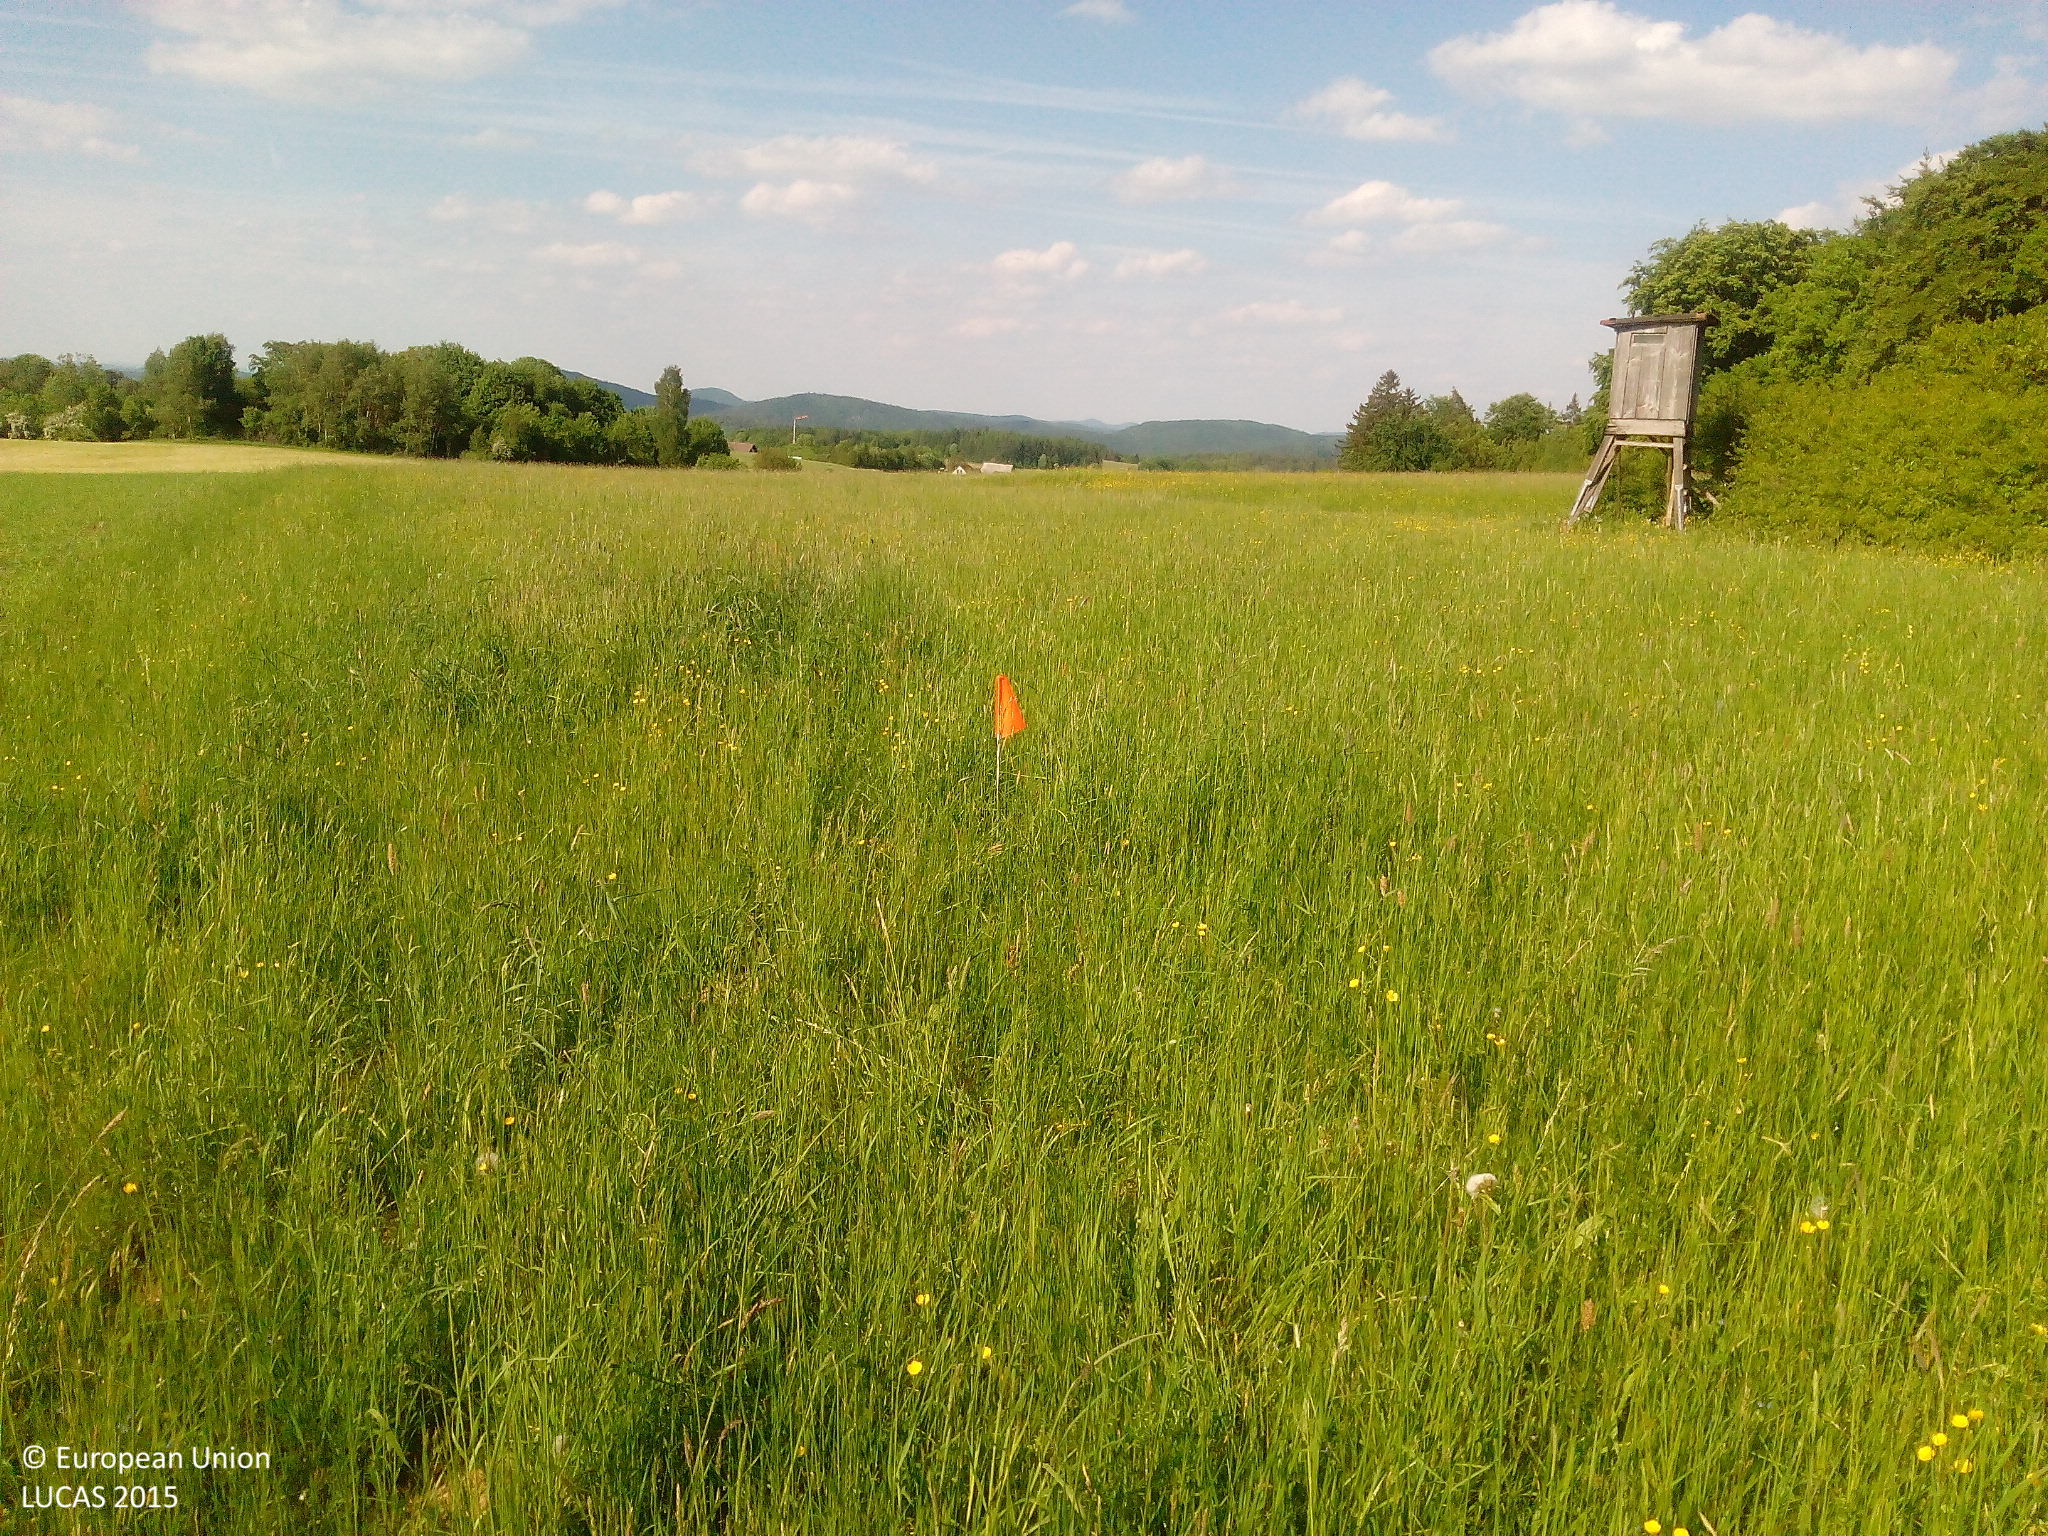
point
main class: Grassland
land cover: Grassland without tree/shrub cover
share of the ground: > 75 %
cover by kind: herbaceous plants 100 %
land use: Agriculture (excluding fallow land and kitchen gardens)
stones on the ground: < 10 %
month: May
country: DE
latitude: 49.4372
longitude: 11.4751
